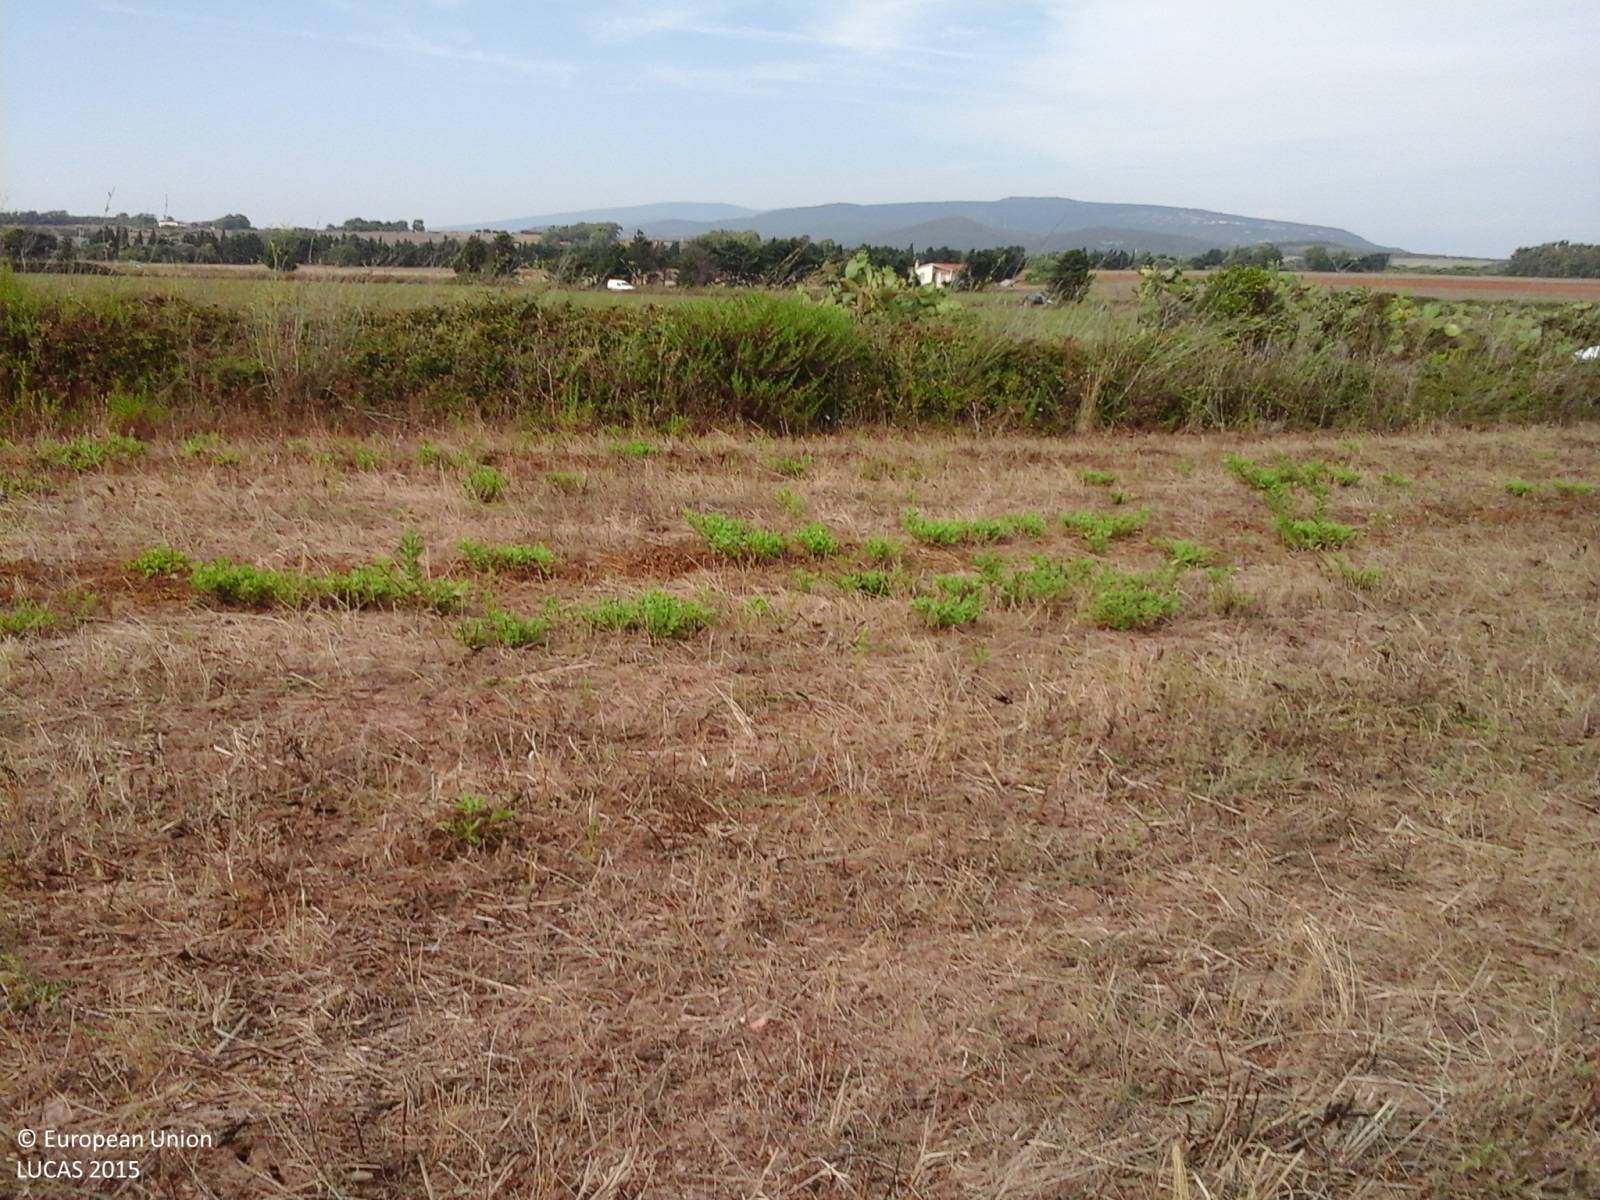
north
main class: Cropland
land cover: Temporary grasslands
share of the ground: > 75 %
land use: Agriculture (excluding fallow land and kitchen gardens)
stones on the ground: < 10 %
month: August
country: IT
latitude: 40.0208
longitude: 8.5200
